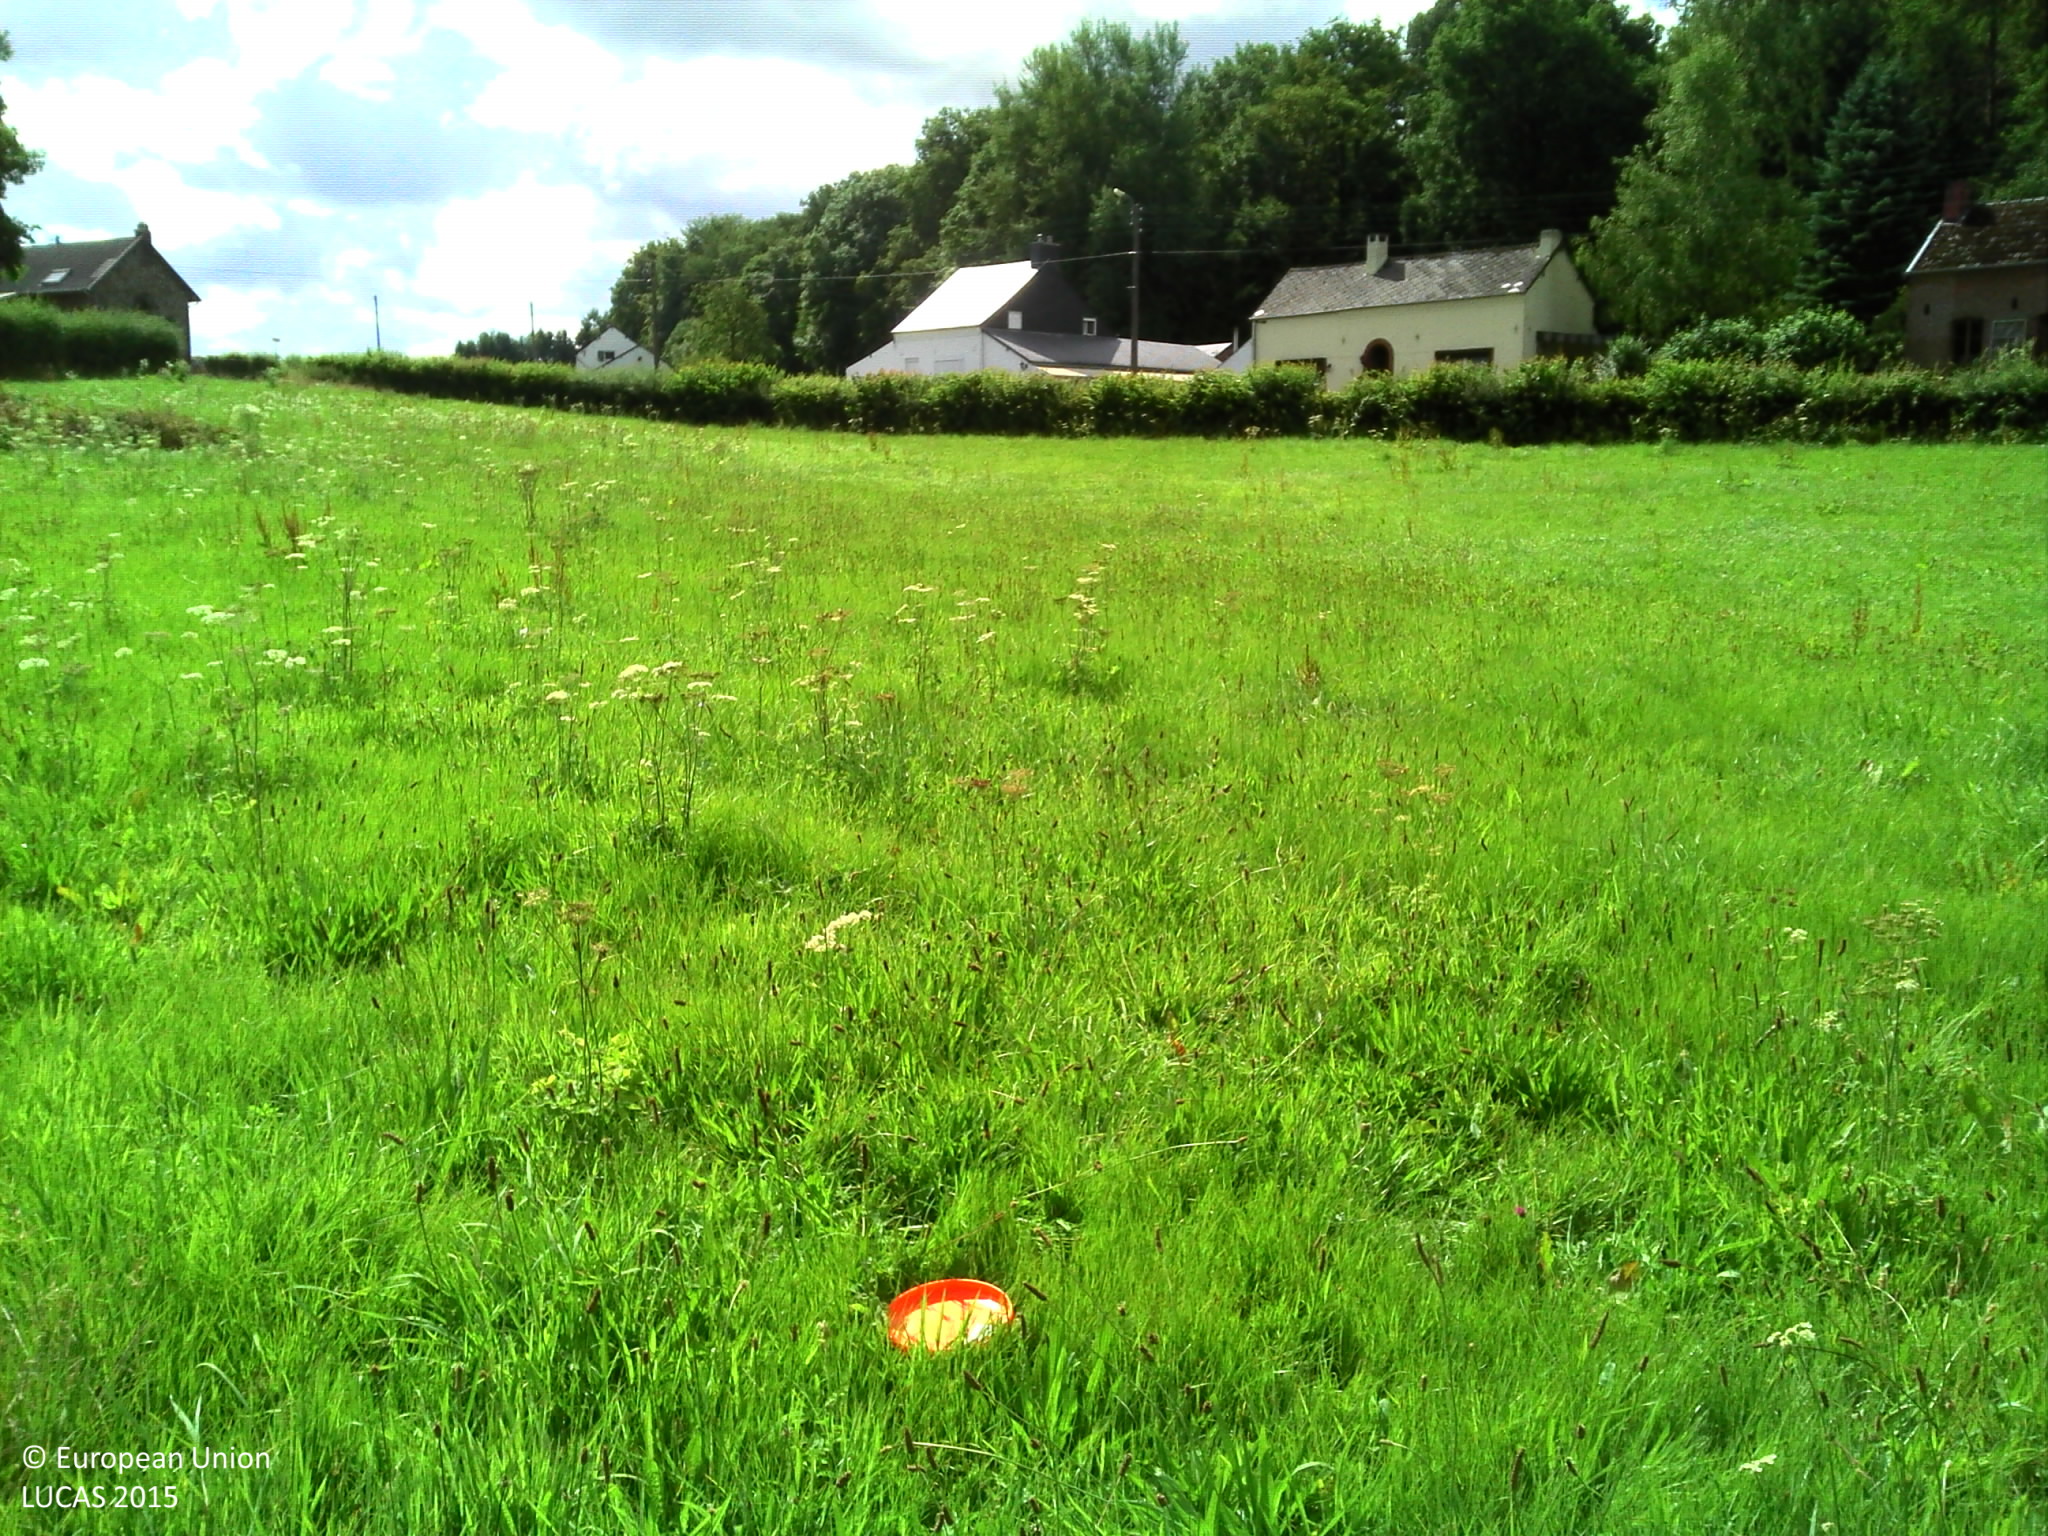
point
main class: Grassland
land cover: Grassland without tree/shrub cover
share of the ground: > 75 %
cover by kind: herbaceous plants 100 %
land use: Agriculture (excluding fallow land and kitchen gardens)
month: July
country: BE
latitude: 50.0173
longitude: 4.1753
